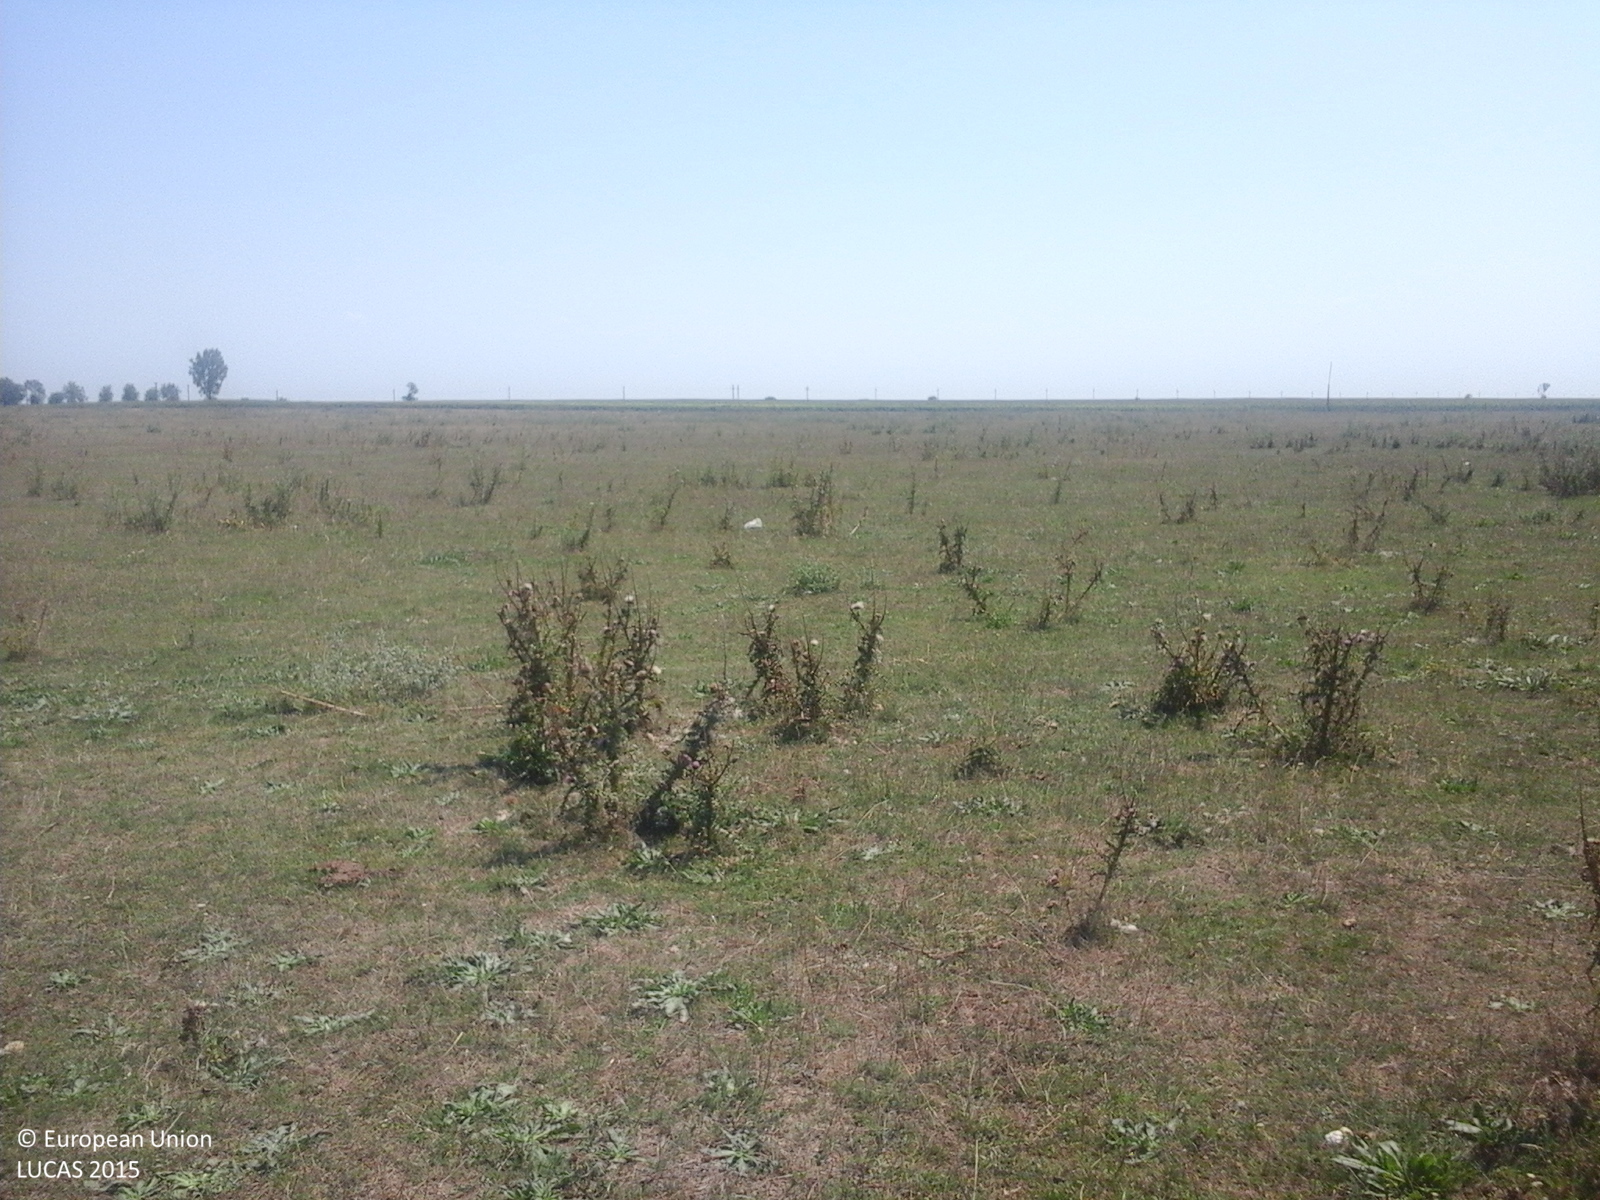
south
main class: Grassland
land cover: Grassland without tree/shrub cover
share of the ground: > 75 %
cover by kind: herbaceous plants 100 %
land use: Agriculture (excluding fallow land and kitchen gardens)
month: July
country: RO
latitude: 44.7804
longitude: 26.7435
